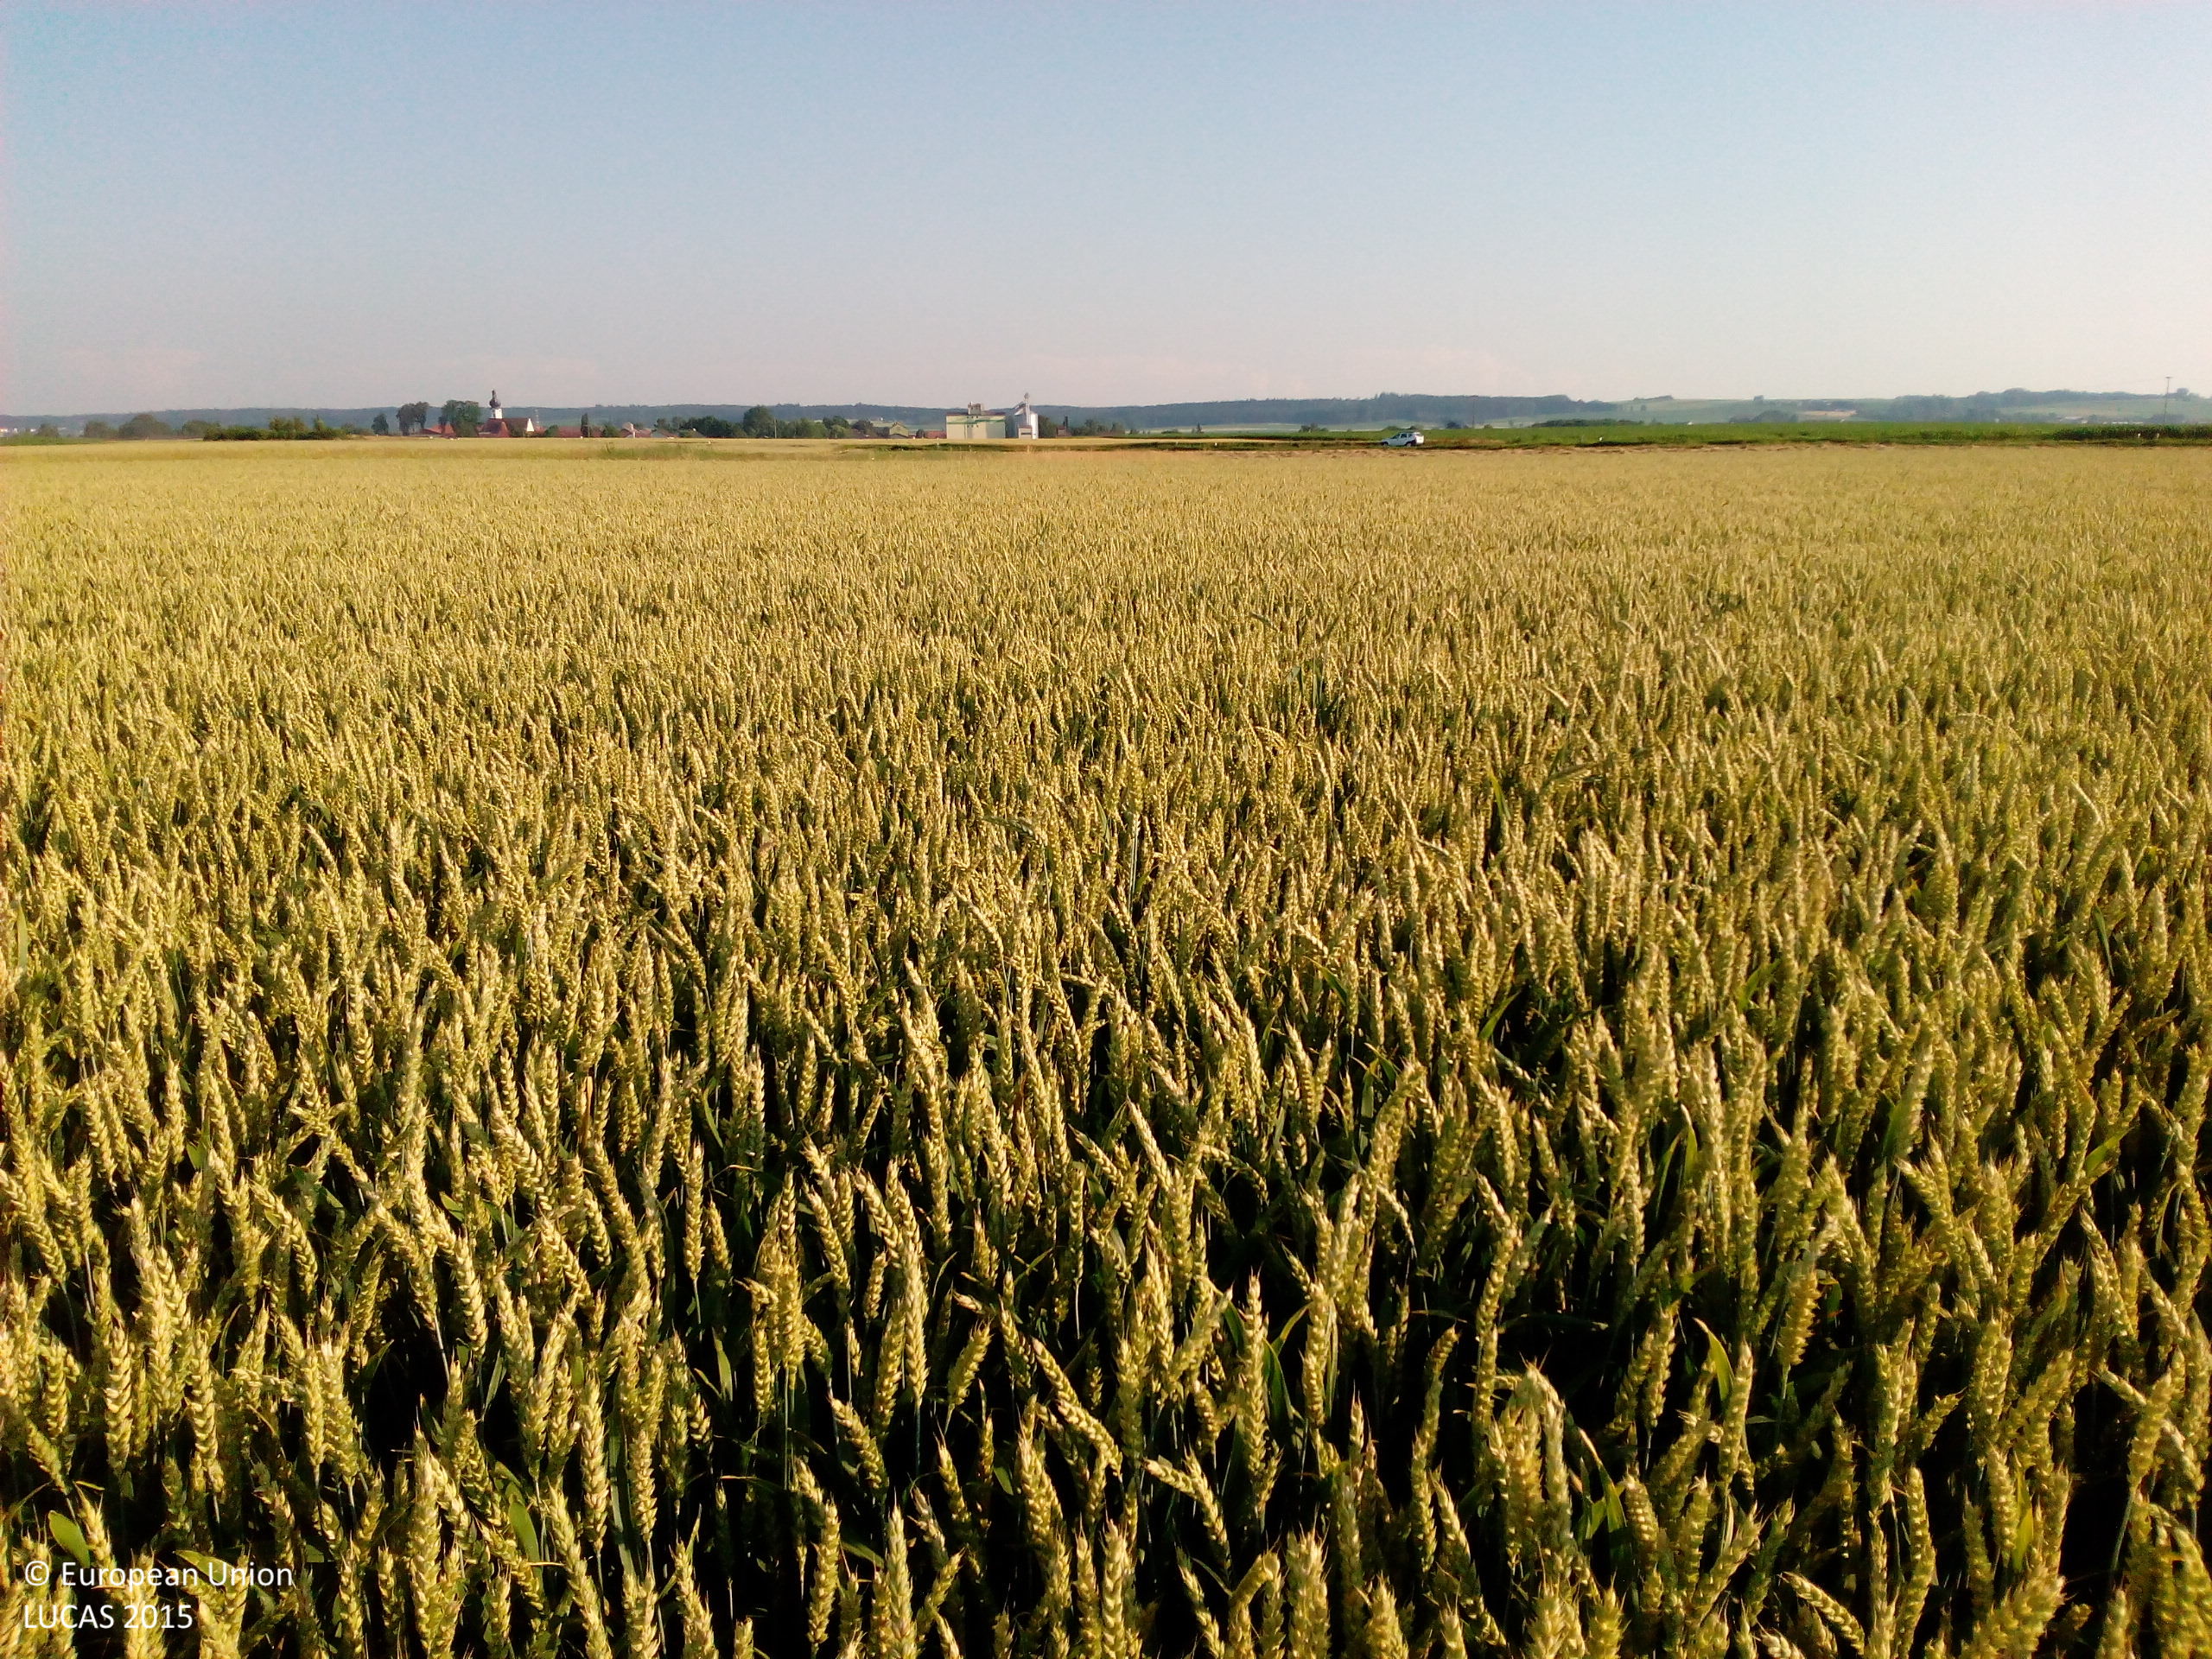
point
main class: Cropland
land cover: Common wheat
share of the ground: > 75 %
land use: Agriculture (excluding fallow land and kitchen gardens)
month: July
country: DE
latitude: 48.7070
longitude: 12.9210
